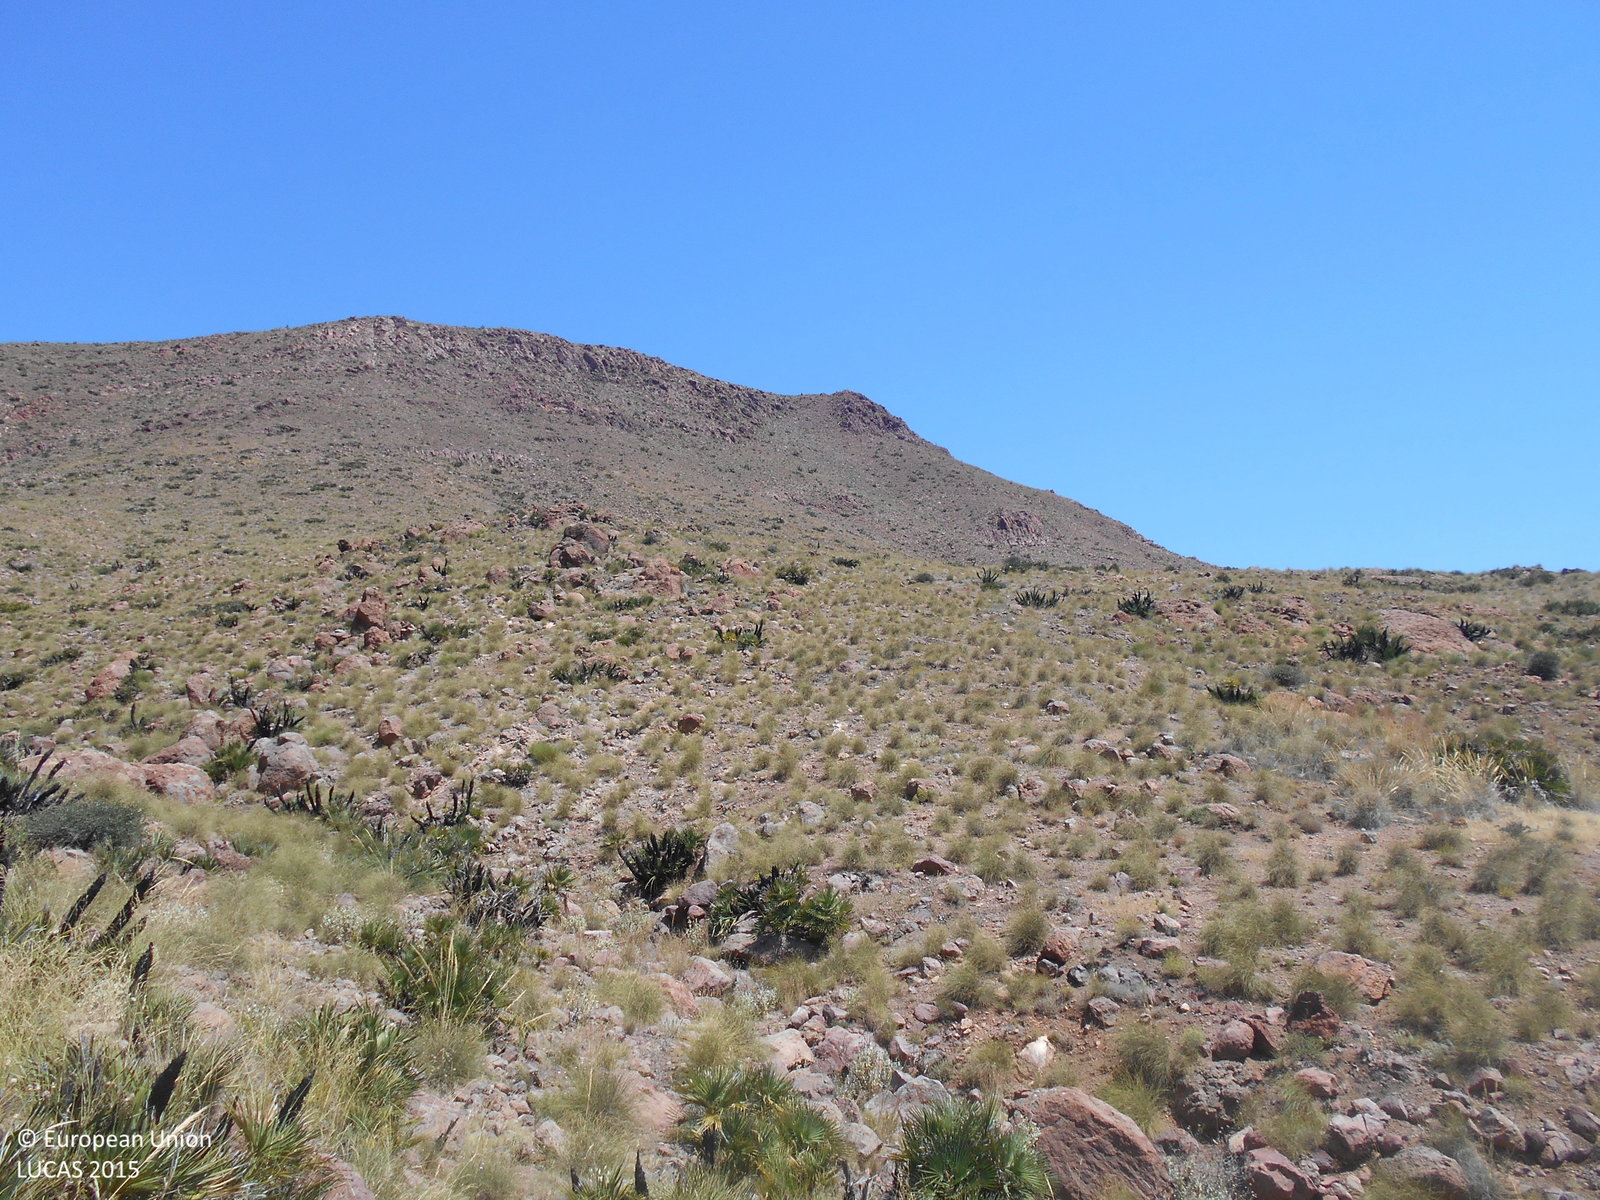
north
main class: Shrubland
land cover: Shrubland without tree cover
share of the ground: 25 - 50 %
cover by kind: shrubs 30 %, consolidated bare surface 30 %, unconsolidated bare surface 30 %, herbaceous plants 10 %
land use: Semi-natural and natural areas not in use
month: May
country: ES
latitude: 36.8054
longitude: -2.1115
